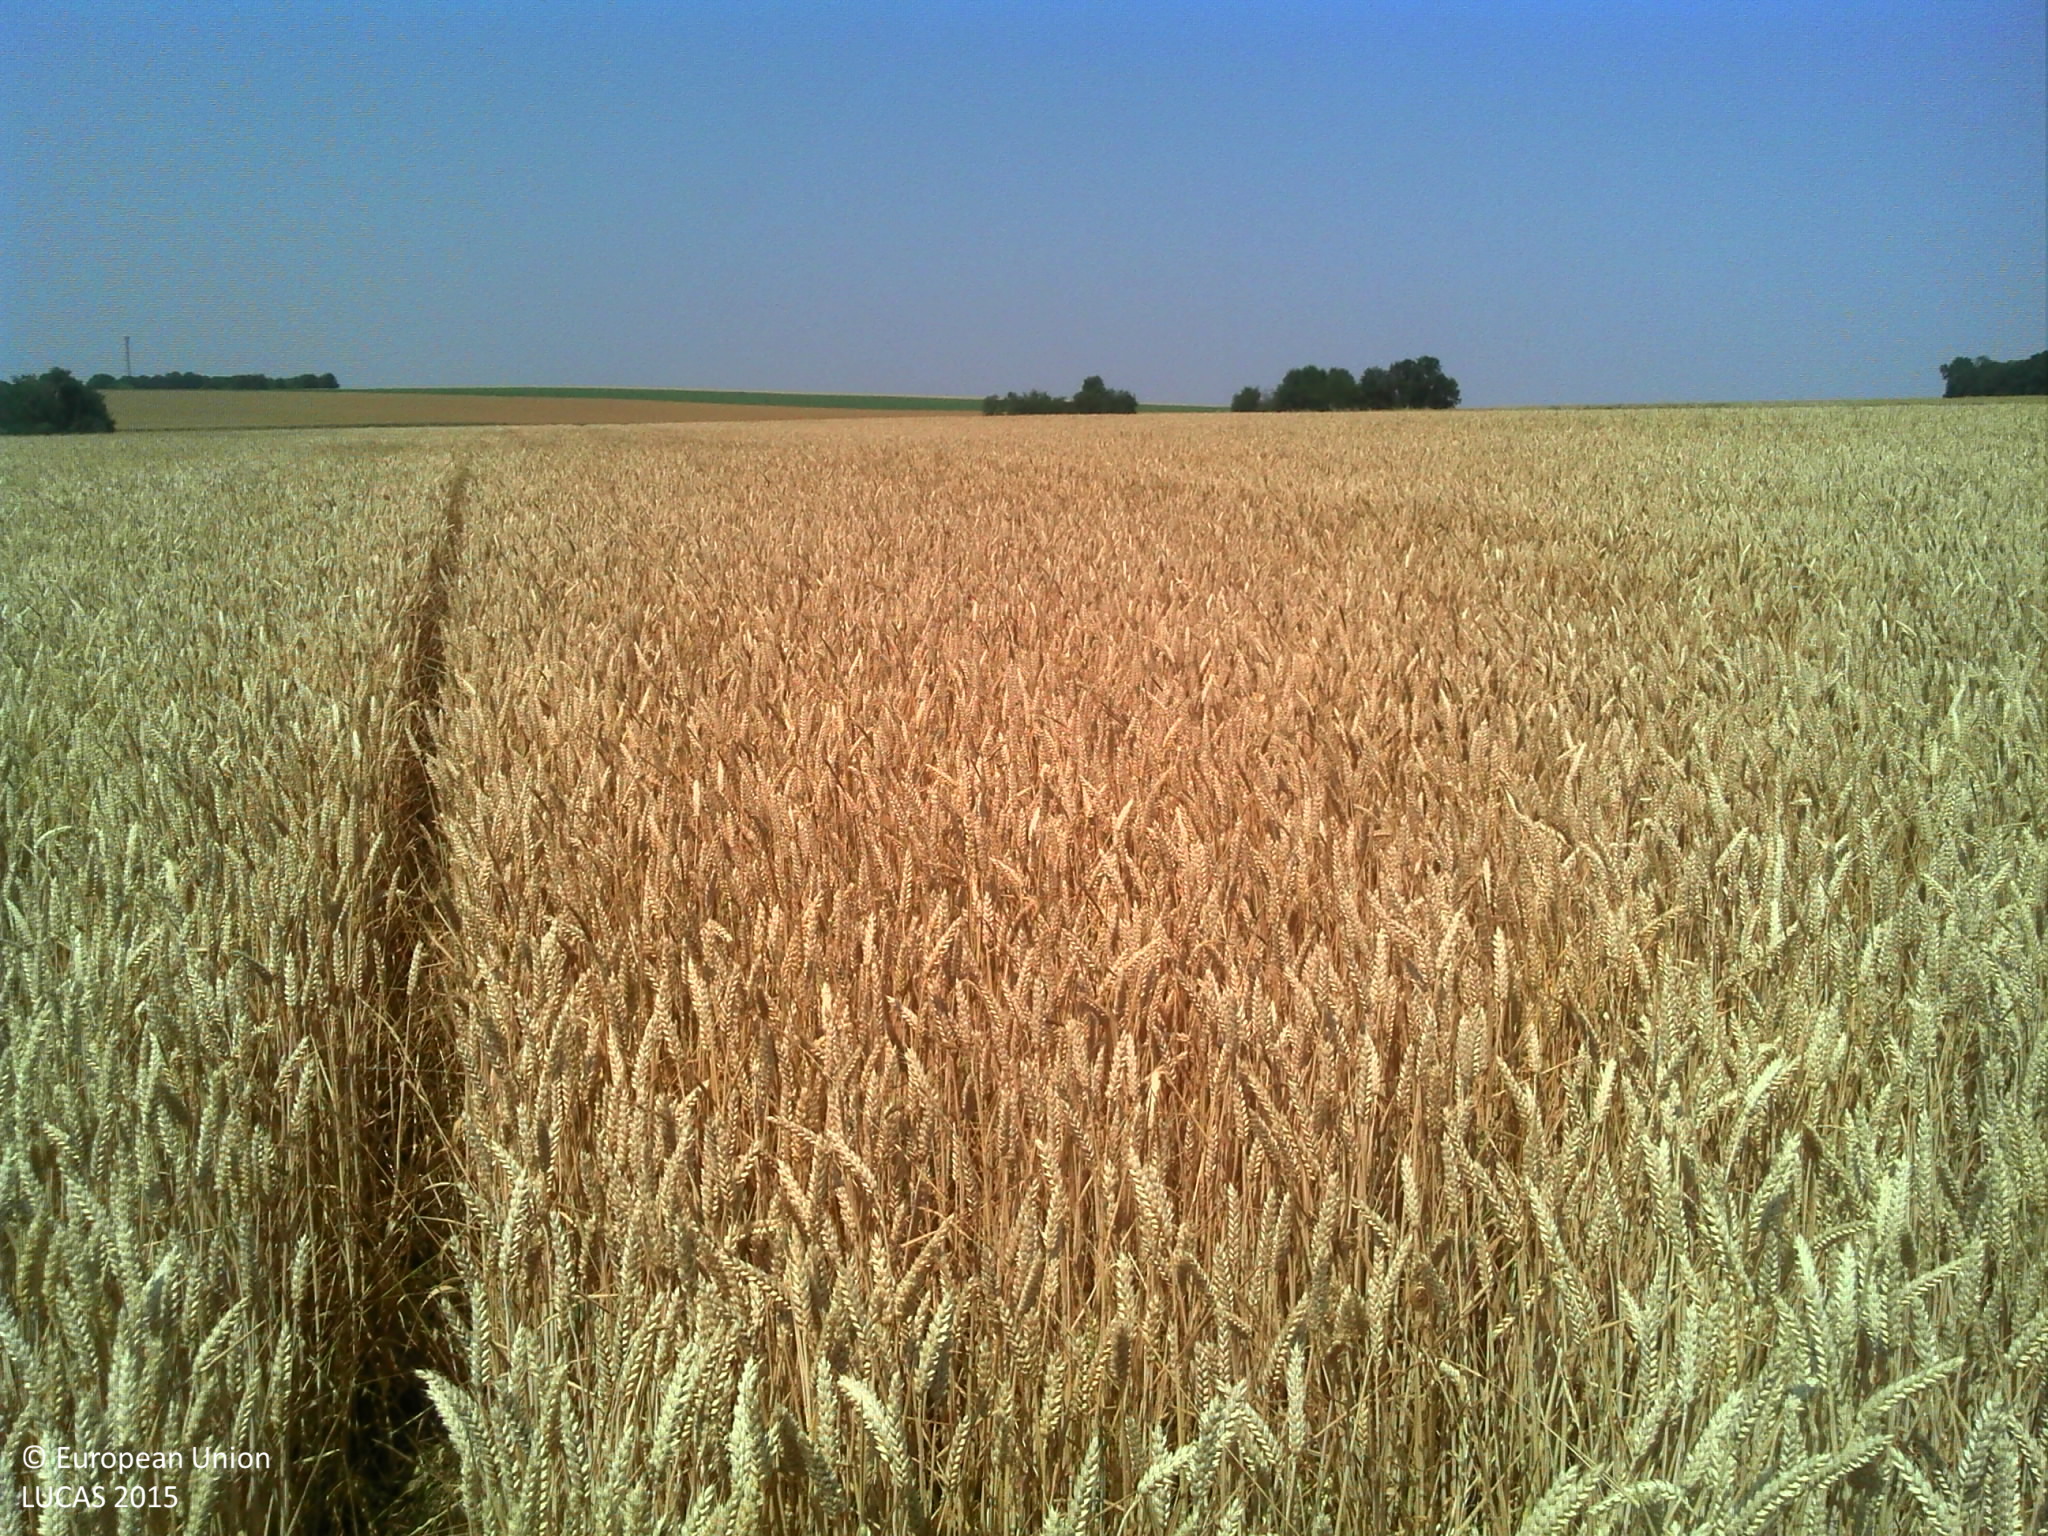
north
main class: Cropland
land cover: Common wheat
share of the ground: > 75 %
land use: Agriculture (excluding fallow land and kitchen gardens)
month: July
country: FR
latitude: 49.1562
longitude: 3.2871
